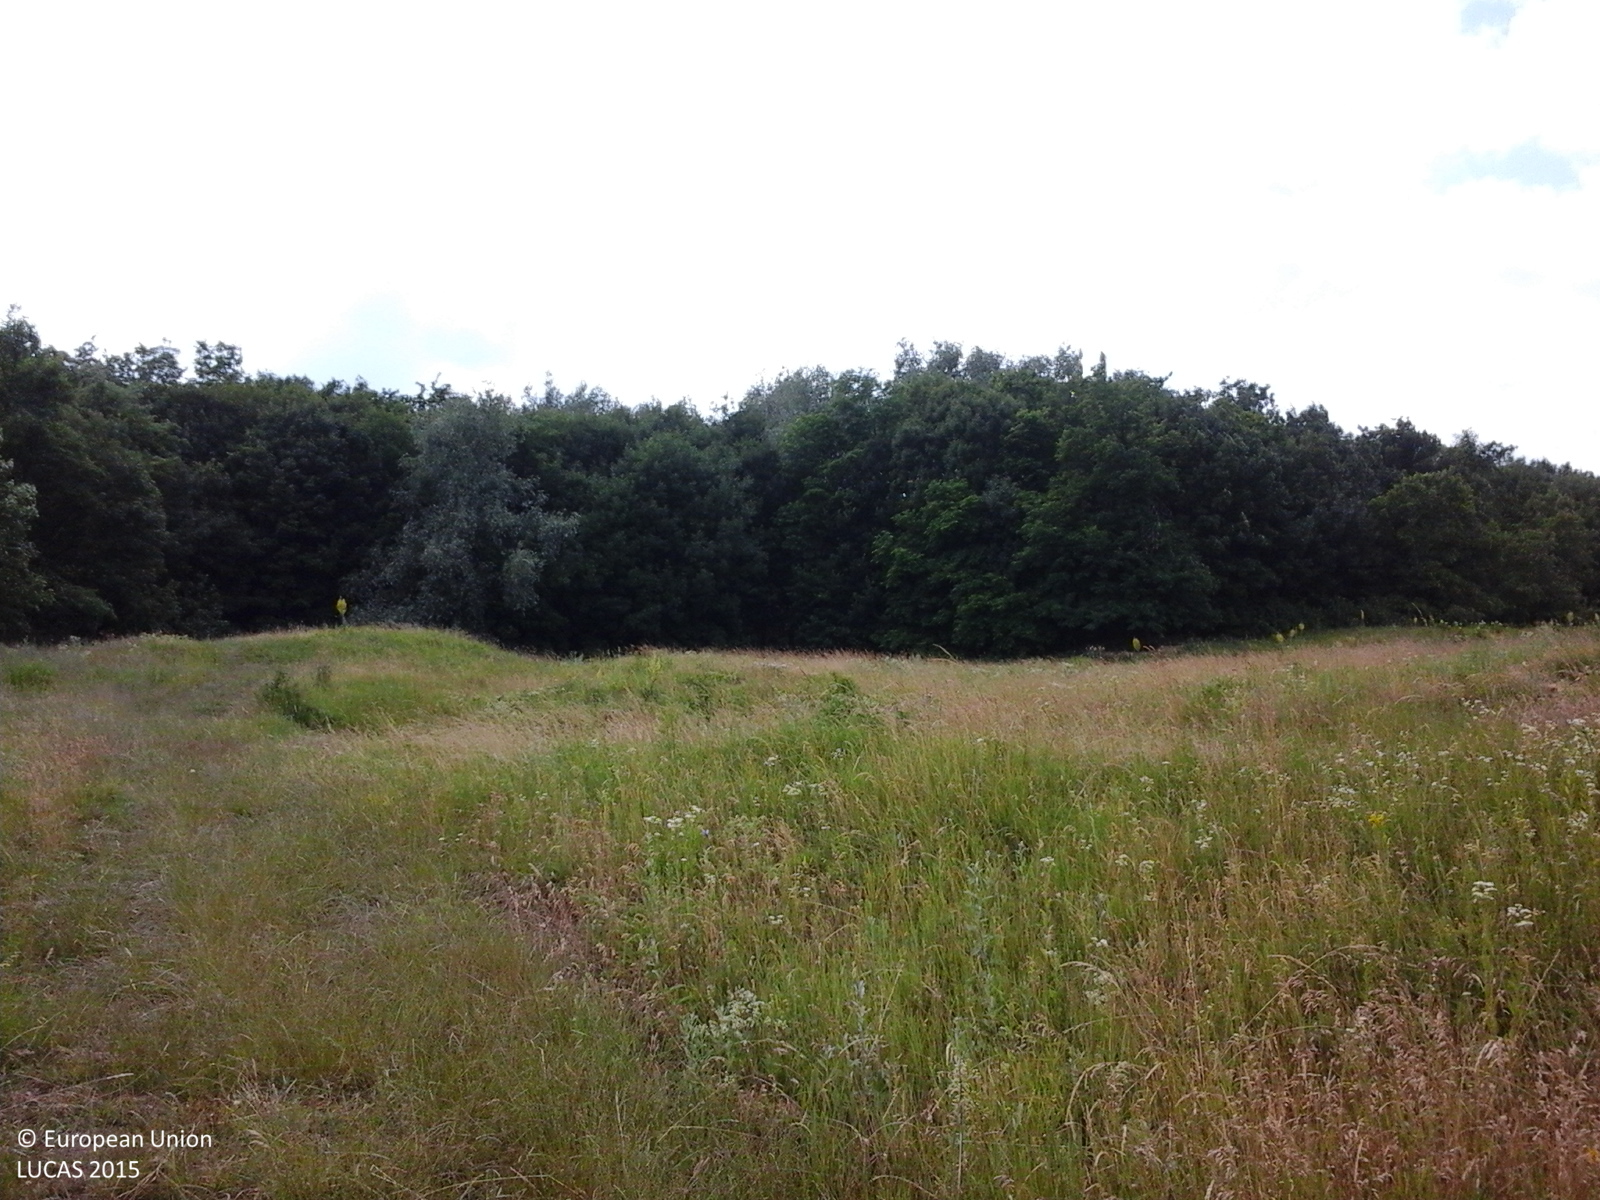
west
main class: Grassland
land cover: Grassland without tree/shrub cover
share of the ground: > 75 %
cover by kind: herbaceous plants 100 %
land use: Agriculture (excluding fallow land and kitchen gardens)
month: June
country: RO
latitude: 46.7297
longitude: 27.4221
